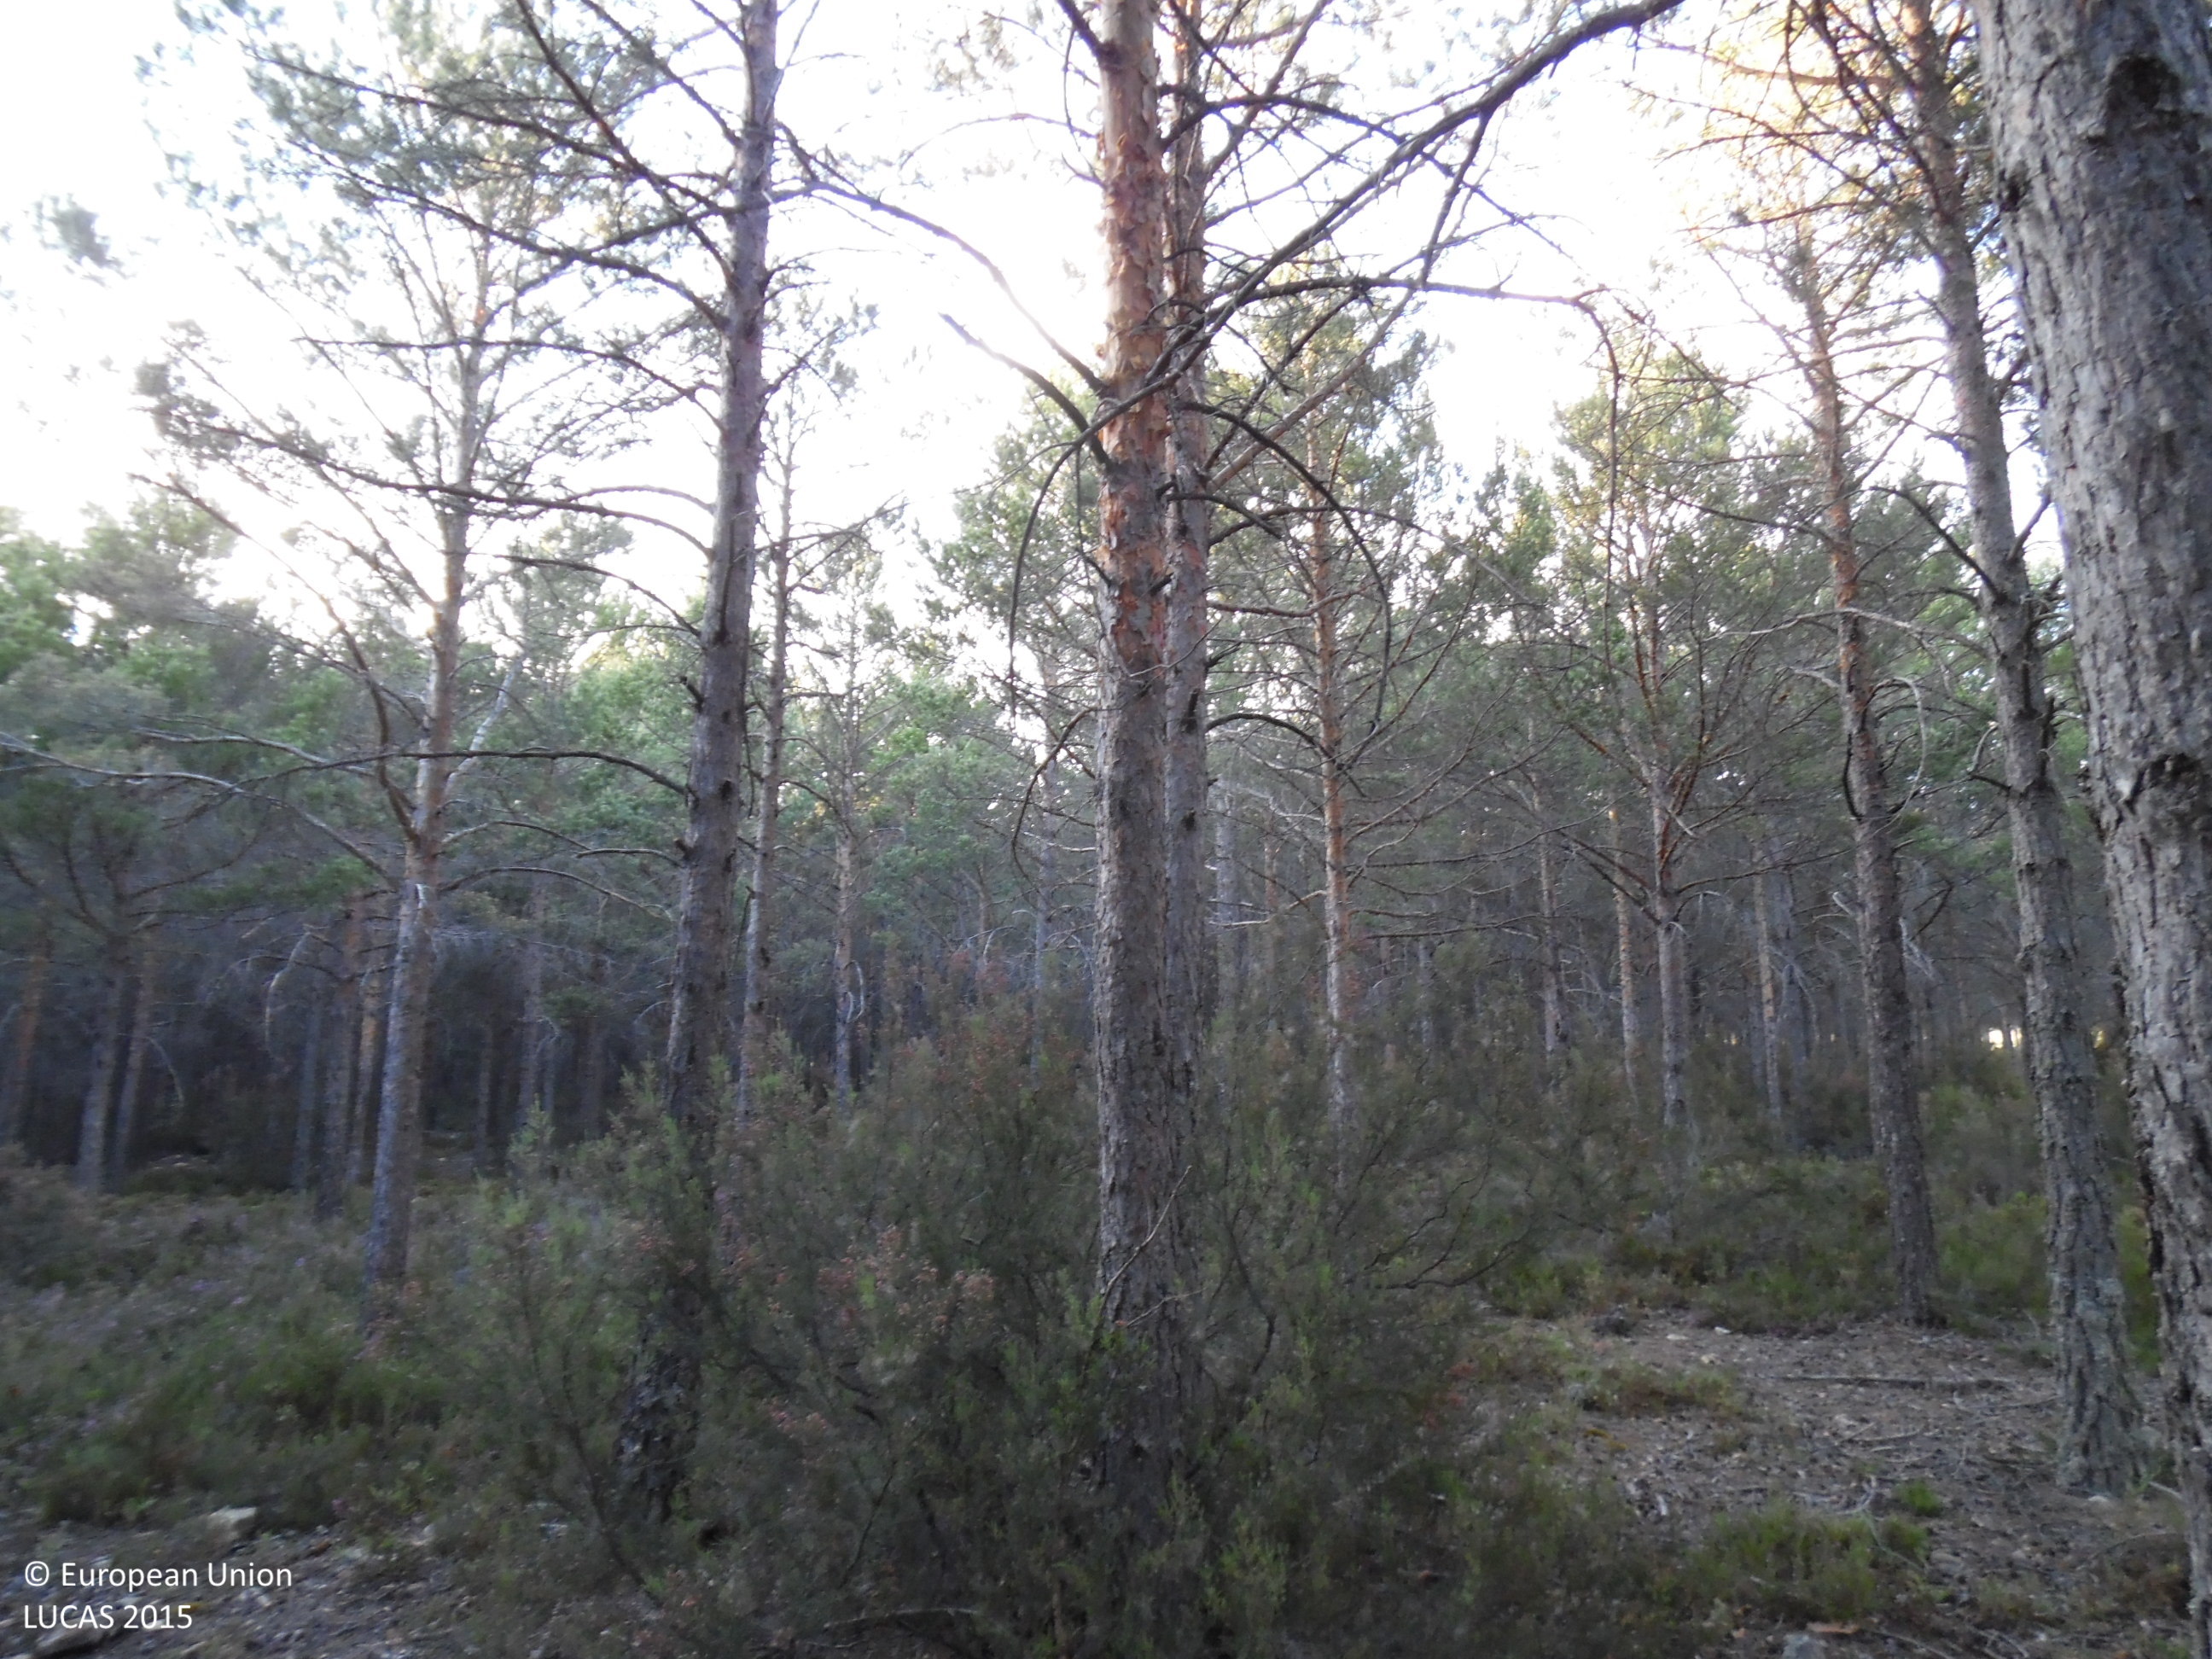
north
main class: Woodland
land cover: Pine dominated coniferous woodland
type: coniferous forest of the mediterranean region
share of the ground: > 75 %
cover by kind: coniferous forest trees 100 %
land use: Forestry
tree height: > 5 m
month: May
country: ES
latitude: 42.2621
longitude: -6.2924
